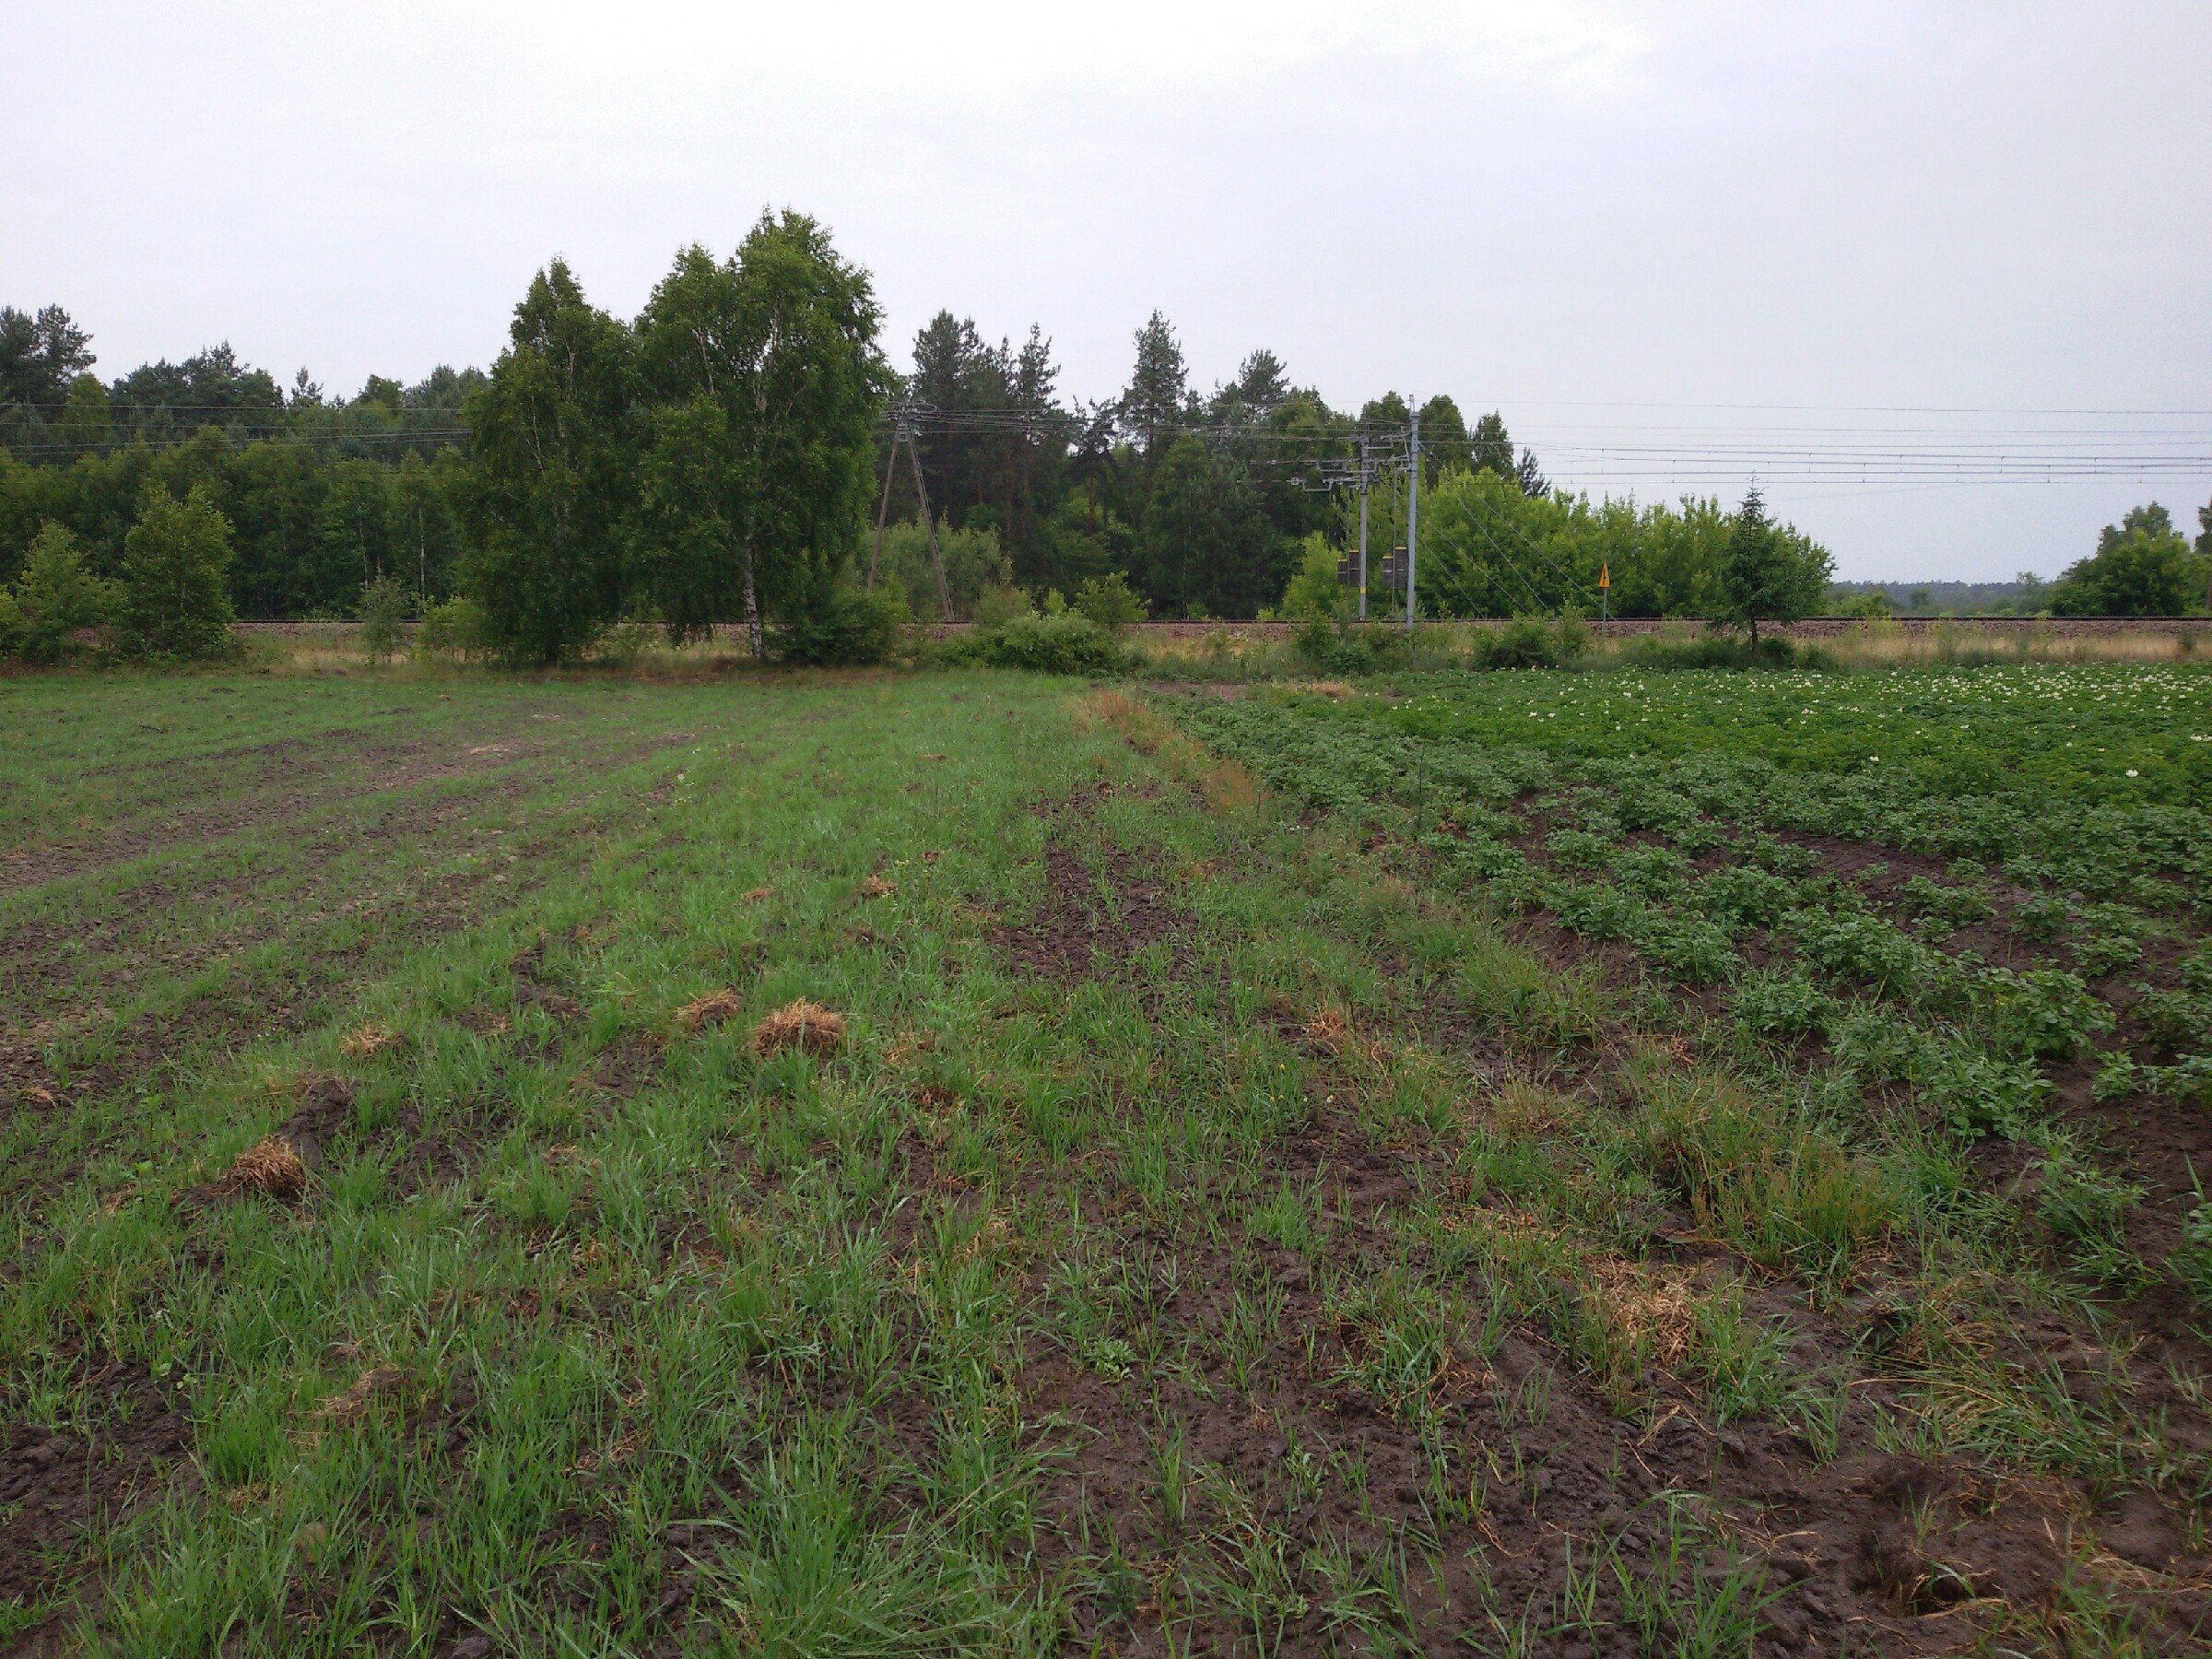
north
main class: Cropland
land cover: Potatoes
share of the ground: > 75 %
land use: Agriculture (excluding fallow land and kitchen gardens)
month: June
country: PL
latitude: 51.9940
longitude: 22.9338
